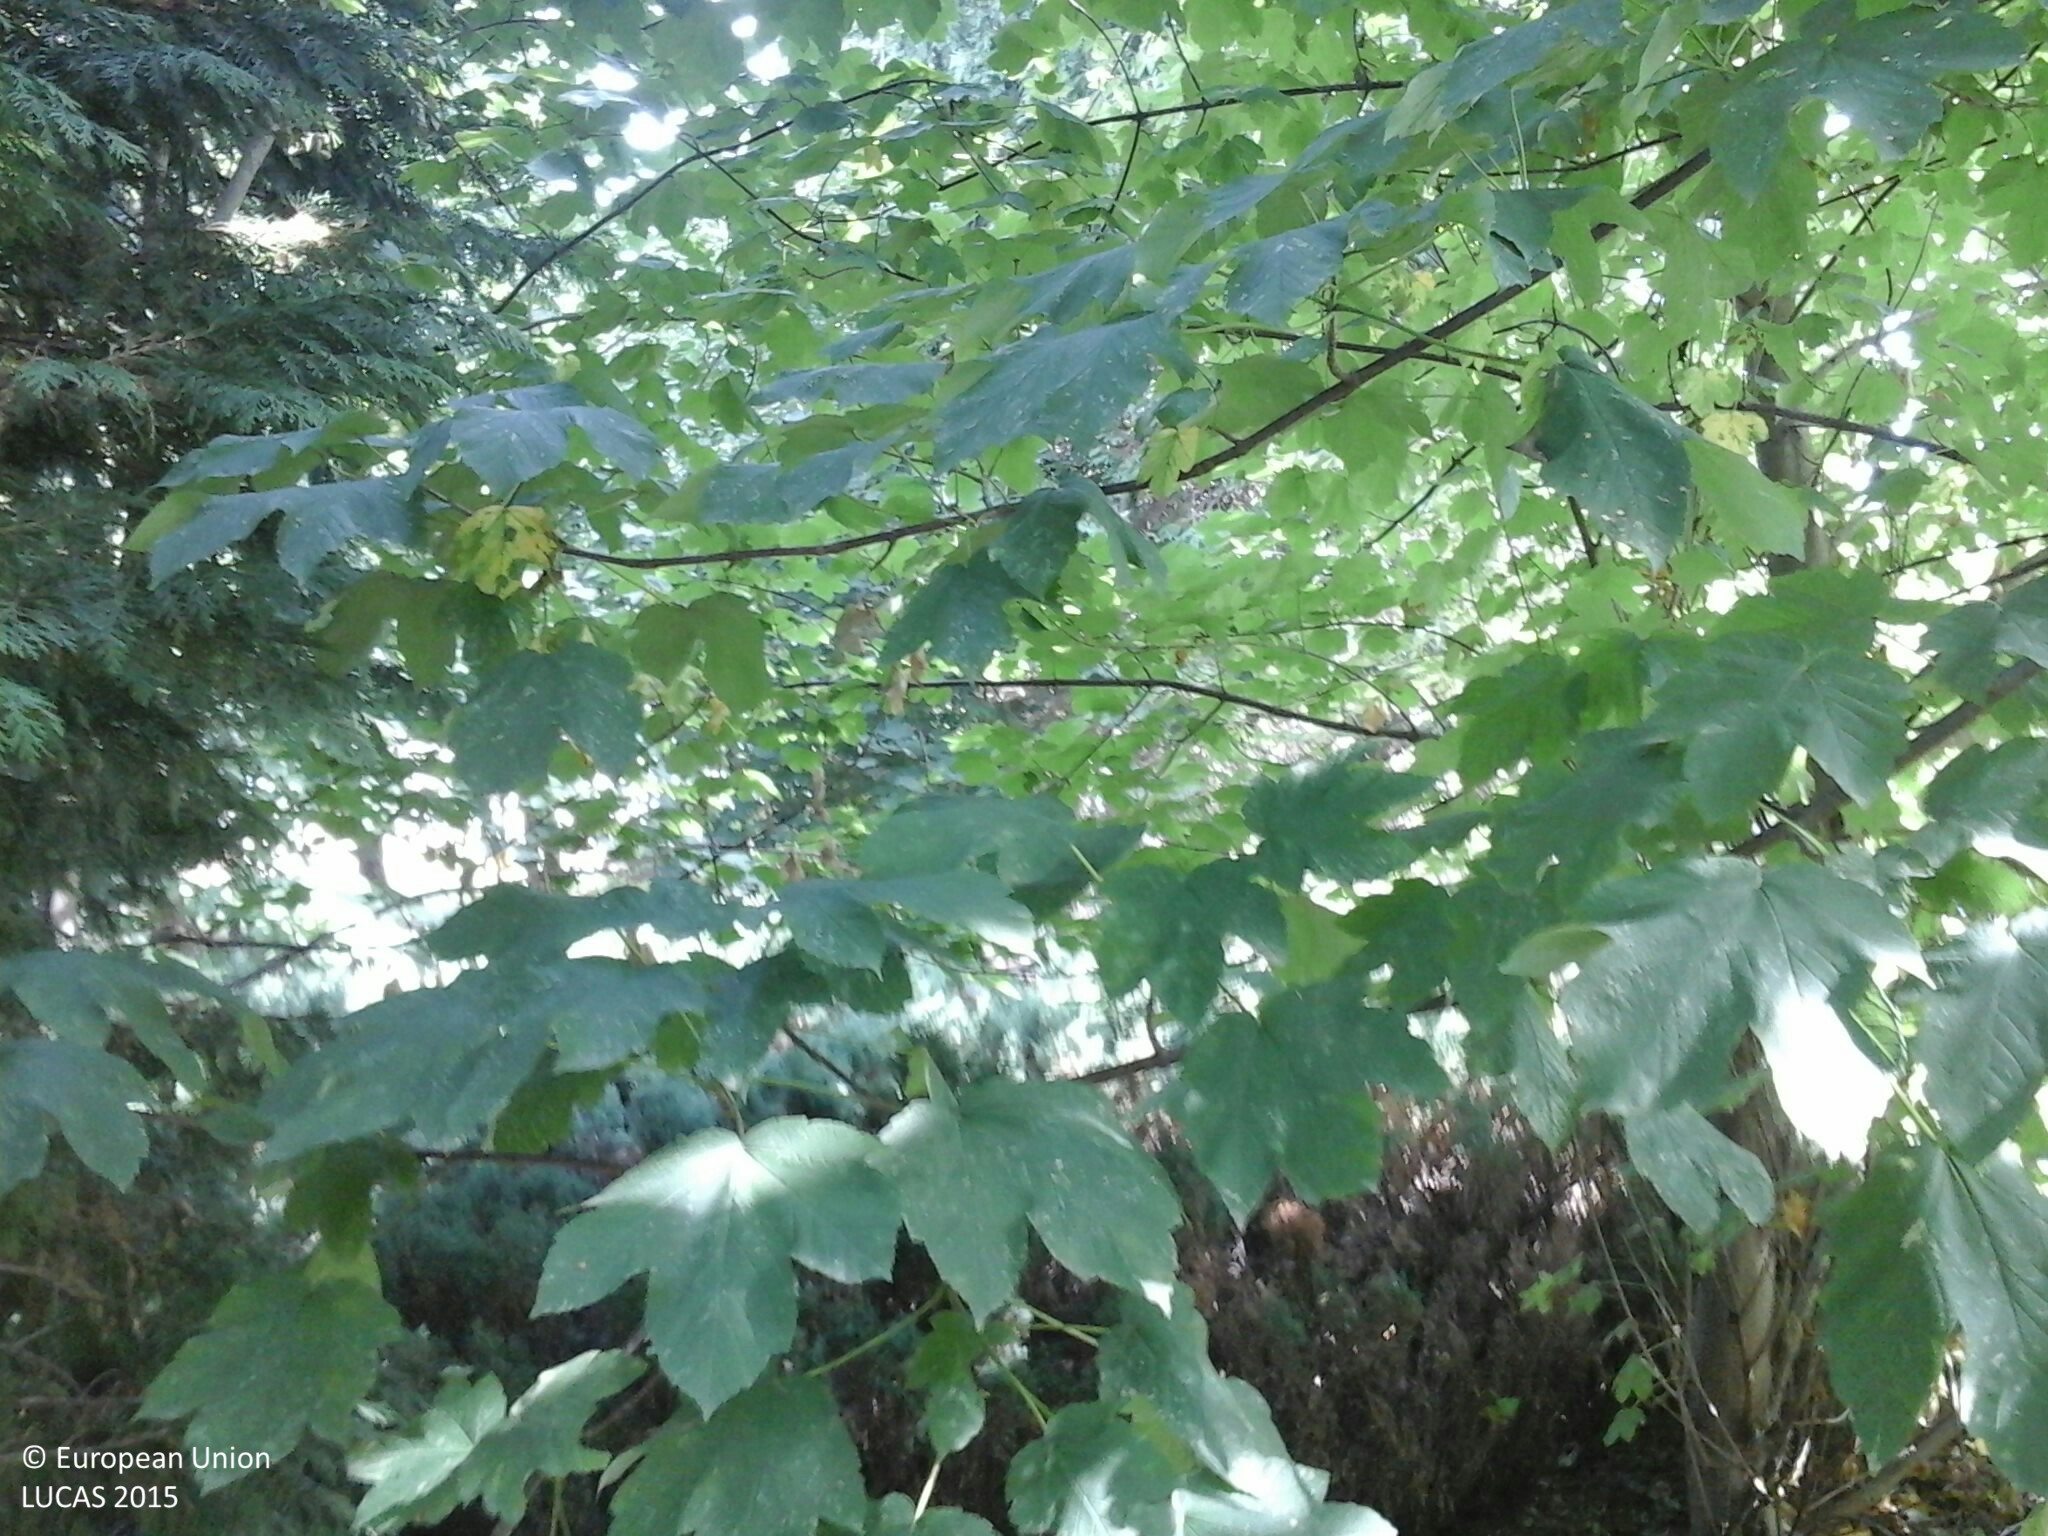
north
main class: Woodland
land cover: Broadleaved woodland
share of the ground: 50 - 75 %
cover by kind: broadleaved forest trees 70 %, herbaceous plants 25 %, coniferous forest trees 5 %
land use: Community services
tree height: > 5 m
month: August
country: HU
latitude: 46.8862
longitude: 16.6299
